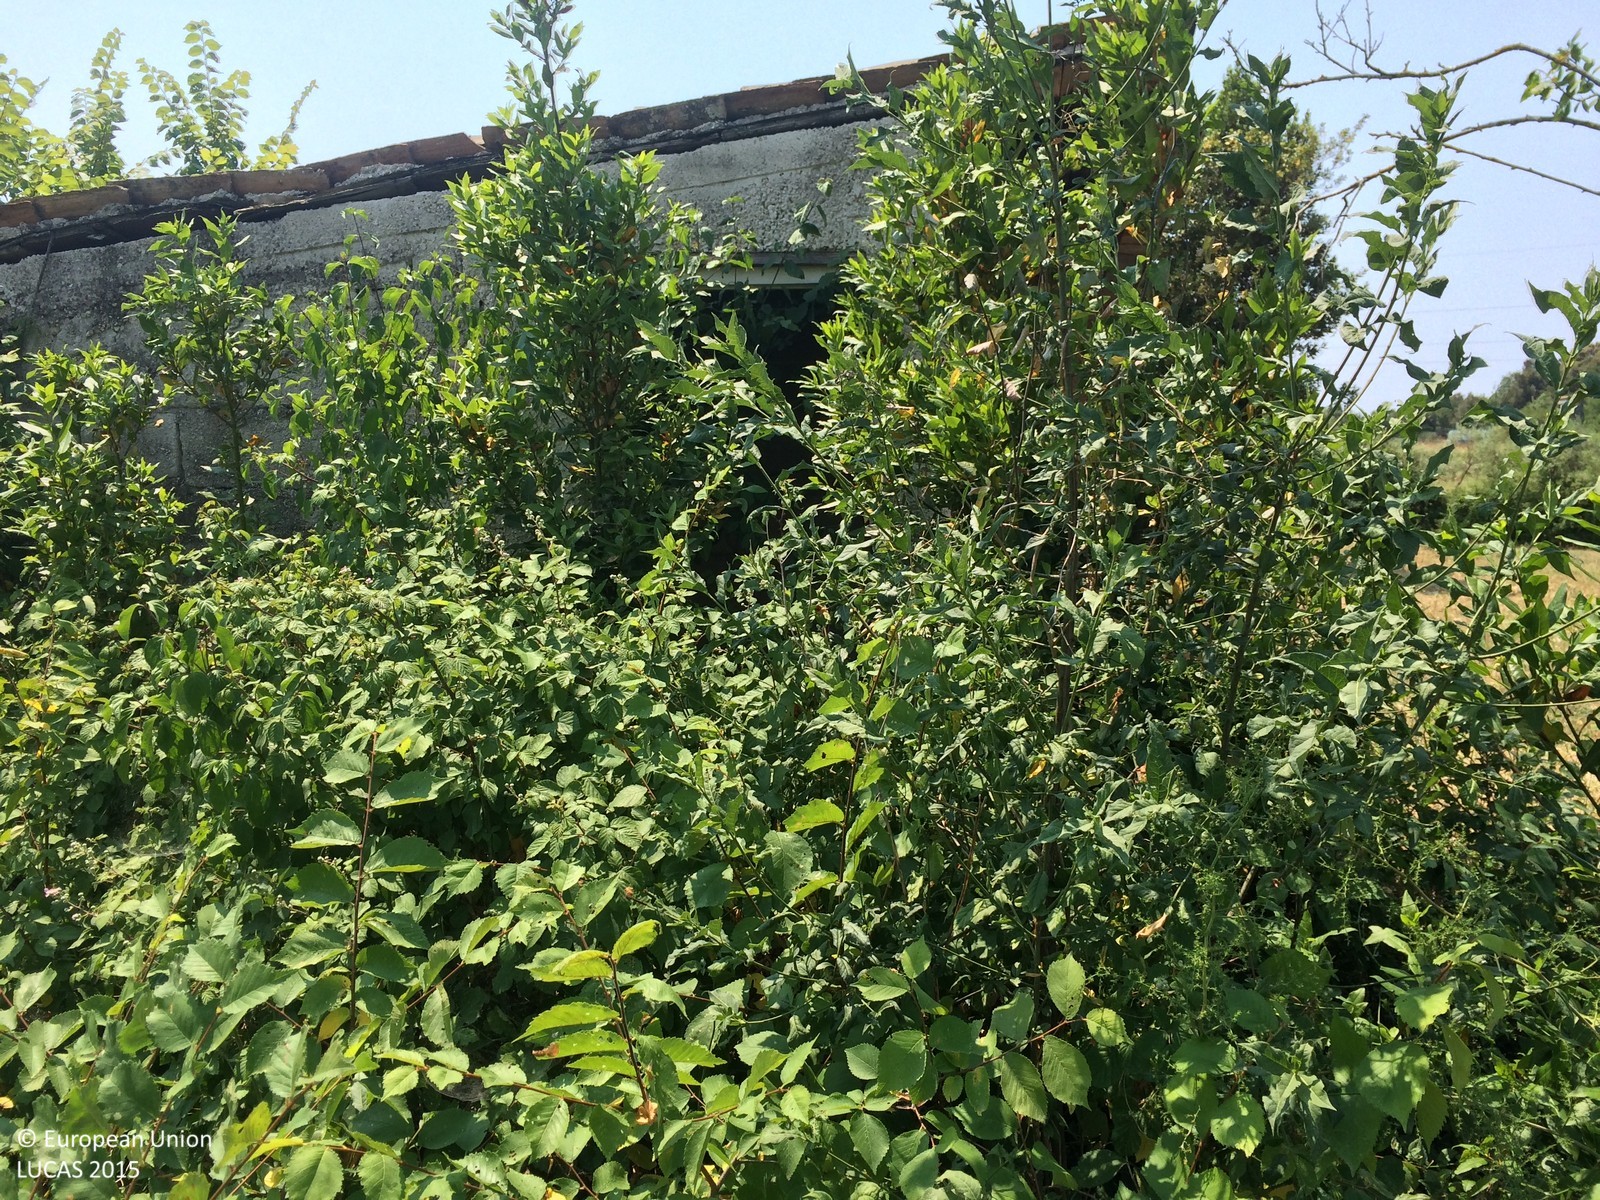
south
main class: Shrubland
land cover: Shrubland without tree cover
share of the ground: < 10 %
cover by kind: herbaceous plants 90 %, shrubs 10 %
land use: Semi-natural and natural areas not in use
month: June
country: HR
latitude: 45.1168
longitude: 13.6429
